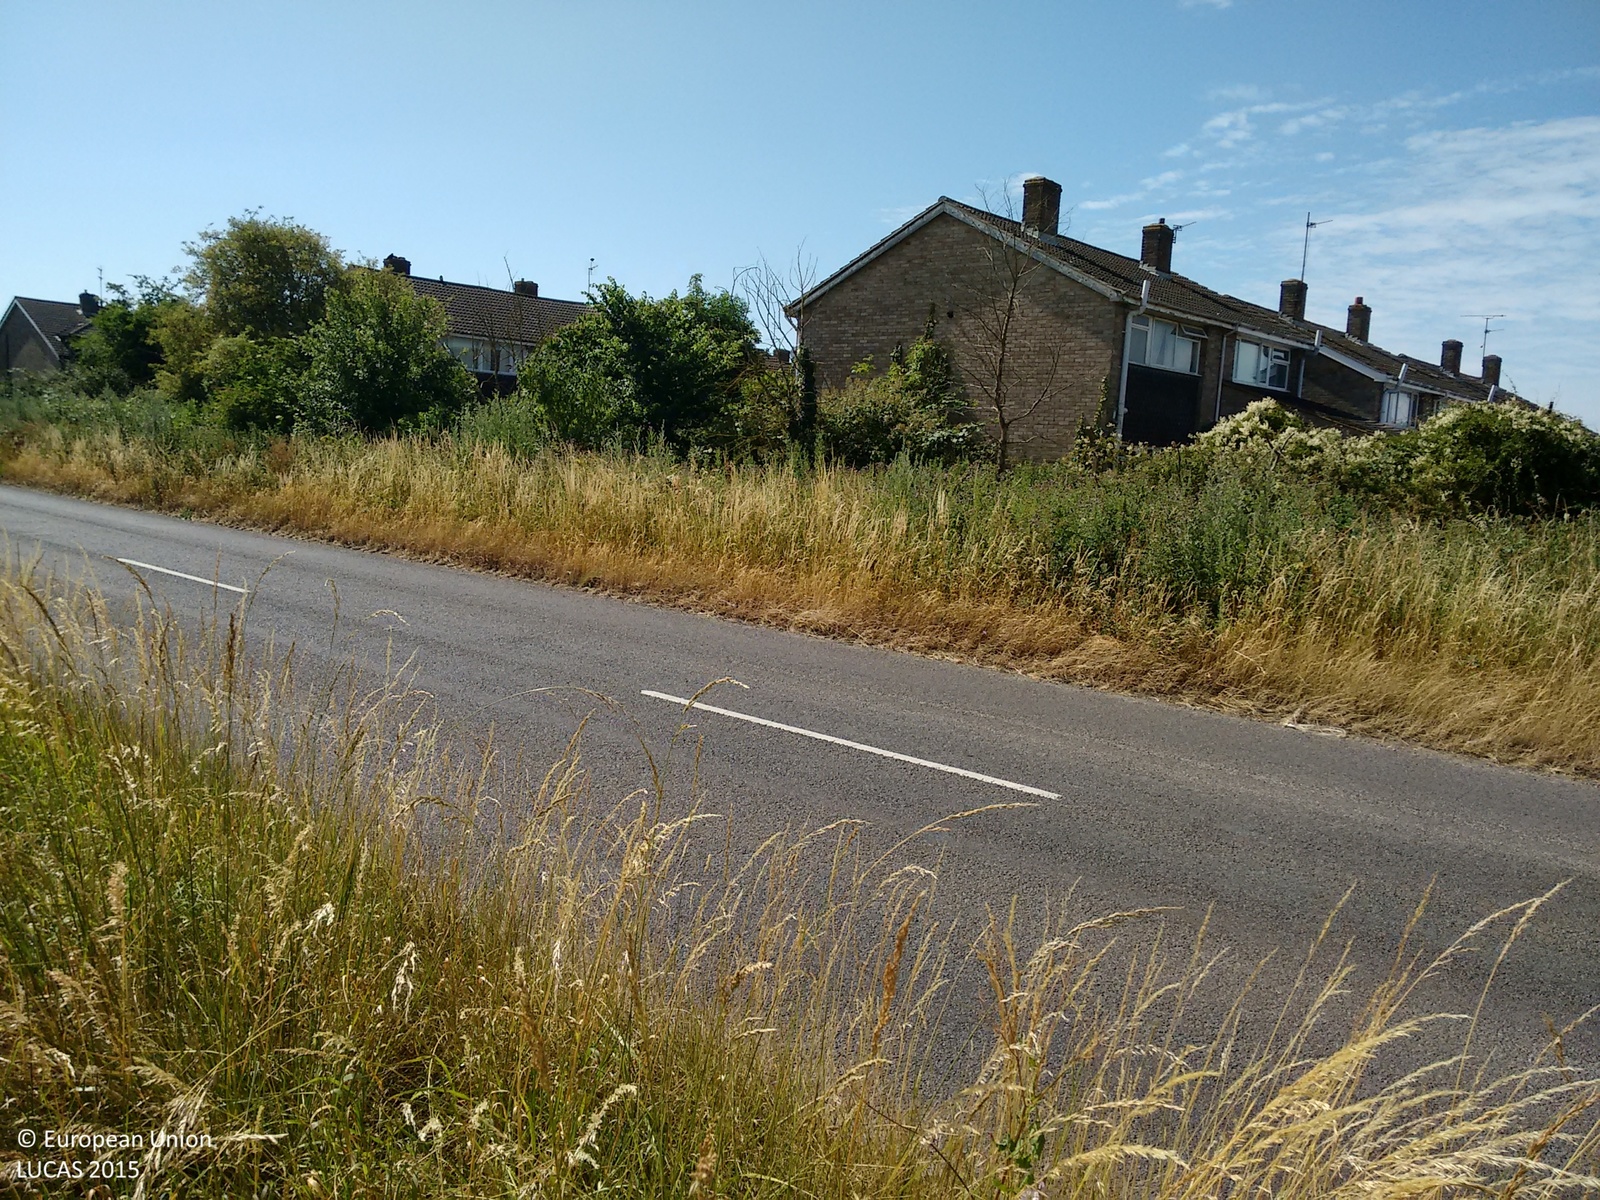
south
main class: Grassland
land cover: Grassland without tree/shrub cover
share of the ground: > 75 %
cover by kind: herbaceous plants 100 %
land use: Air transport
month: July
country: GB
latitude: 51.6755
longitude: -1.0794
